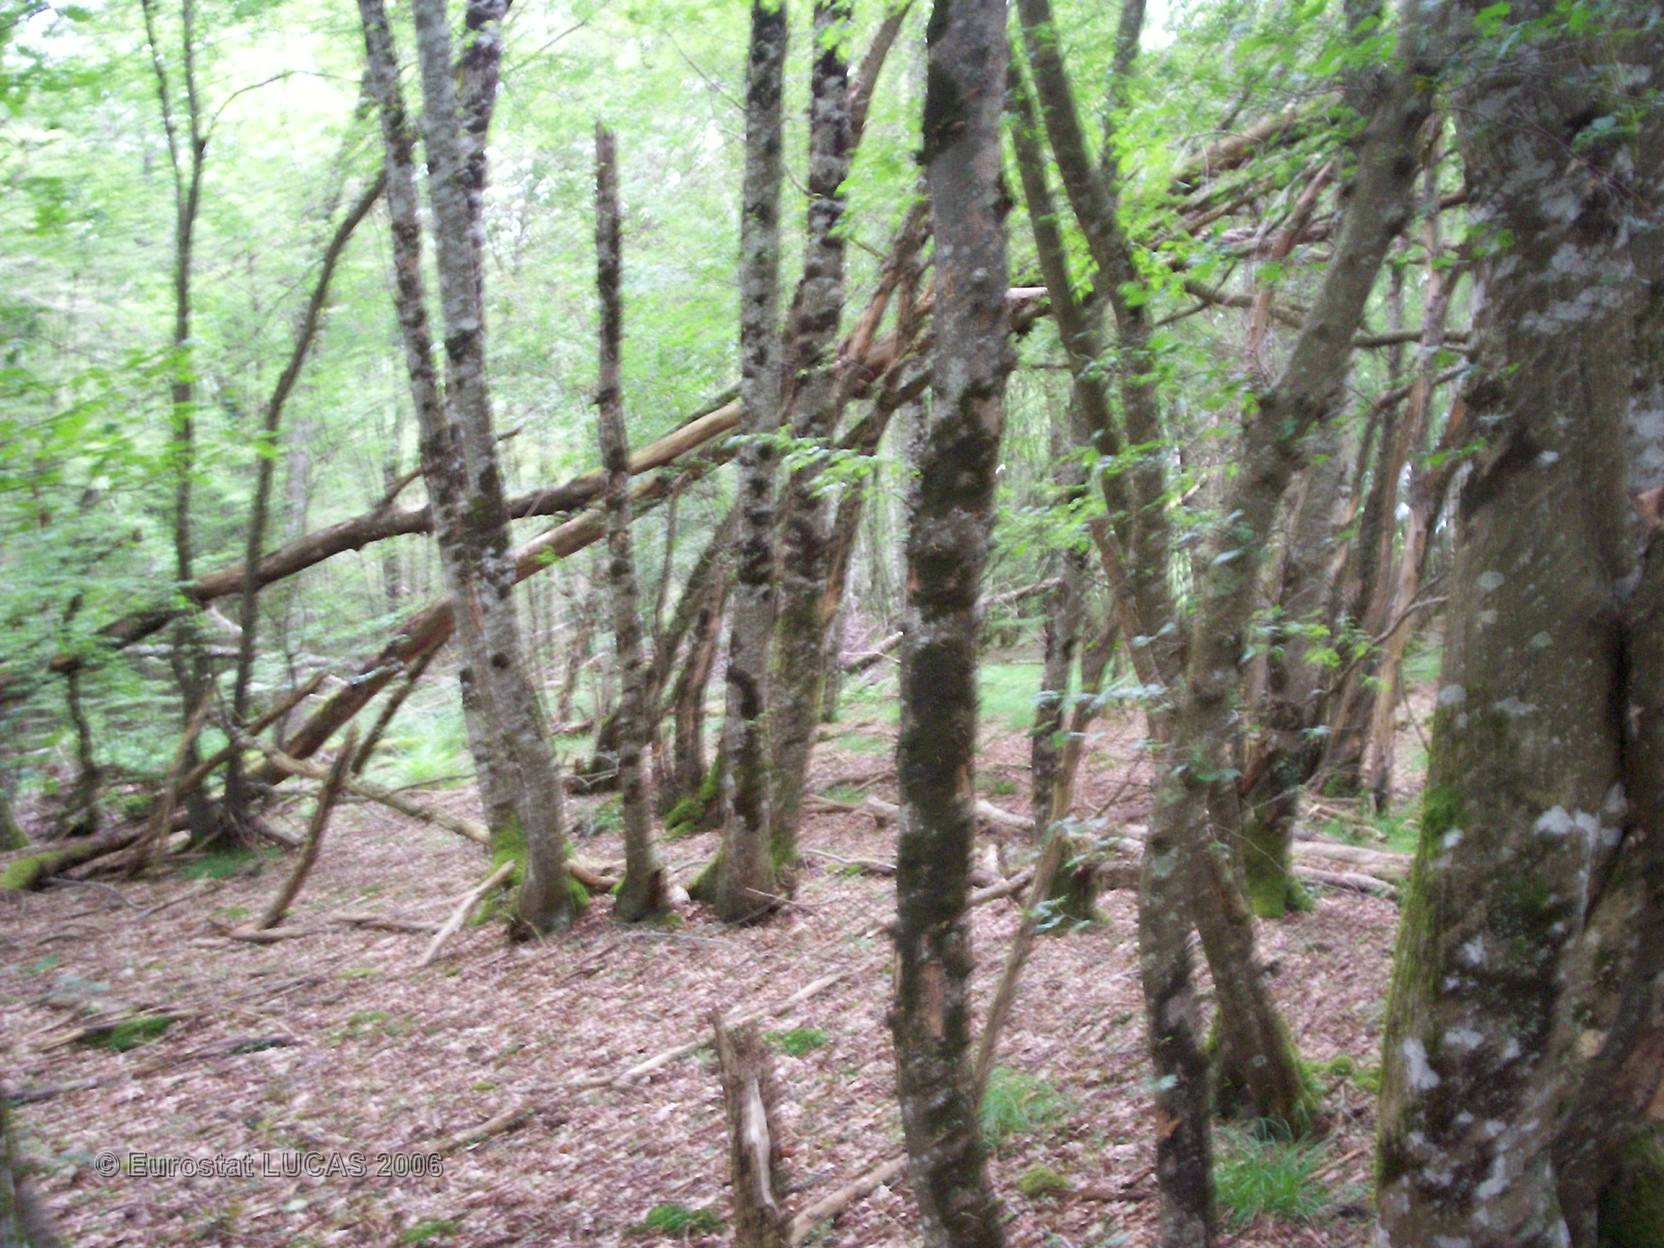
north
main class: Woodland
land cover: Broadleaved forest
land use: Forestry
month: May
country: FR
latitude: 46.8827
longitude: 3.0281
